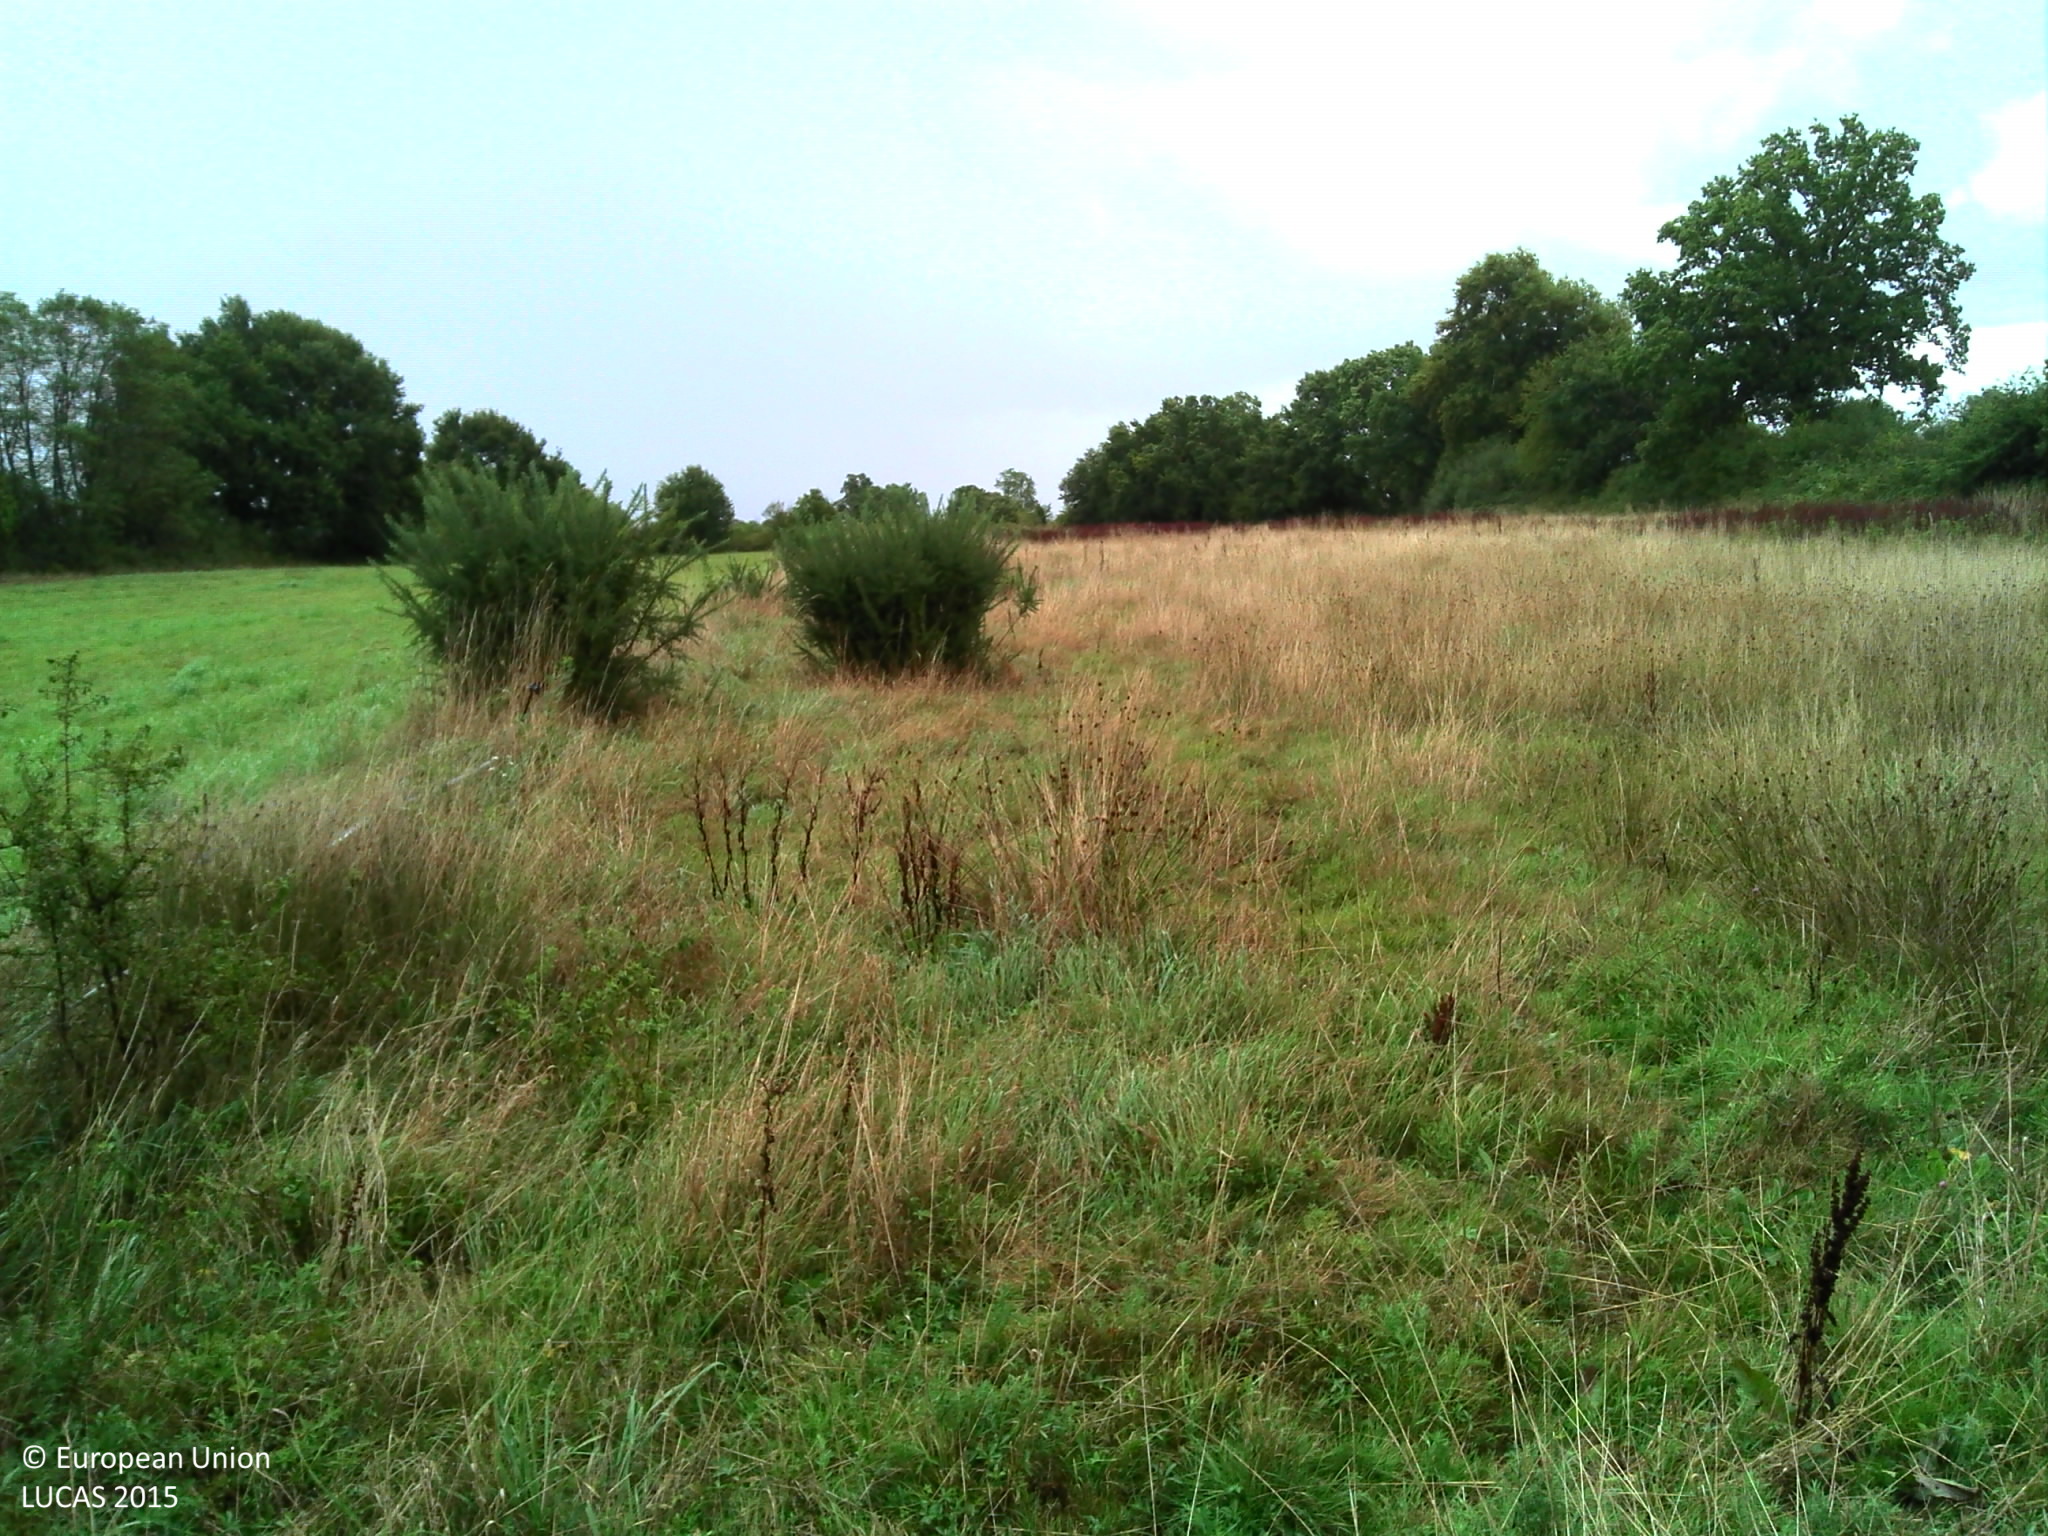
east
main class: Grassland
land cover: Grassland without tree/shrub cover
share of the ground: > 75 %
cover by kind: herbaceous plants 100 %
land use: Agriculture (excluding fallow land and kitchen gardens)
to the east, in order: Grassland without tree/shrub cover; Broadleaved woodland; Grass margins; Tracks; Grass margins; Broadleaved woodland; Fences; Grassland without tree/shrub cover
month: September
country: FR
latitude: 46.6412
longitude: 1.6684
